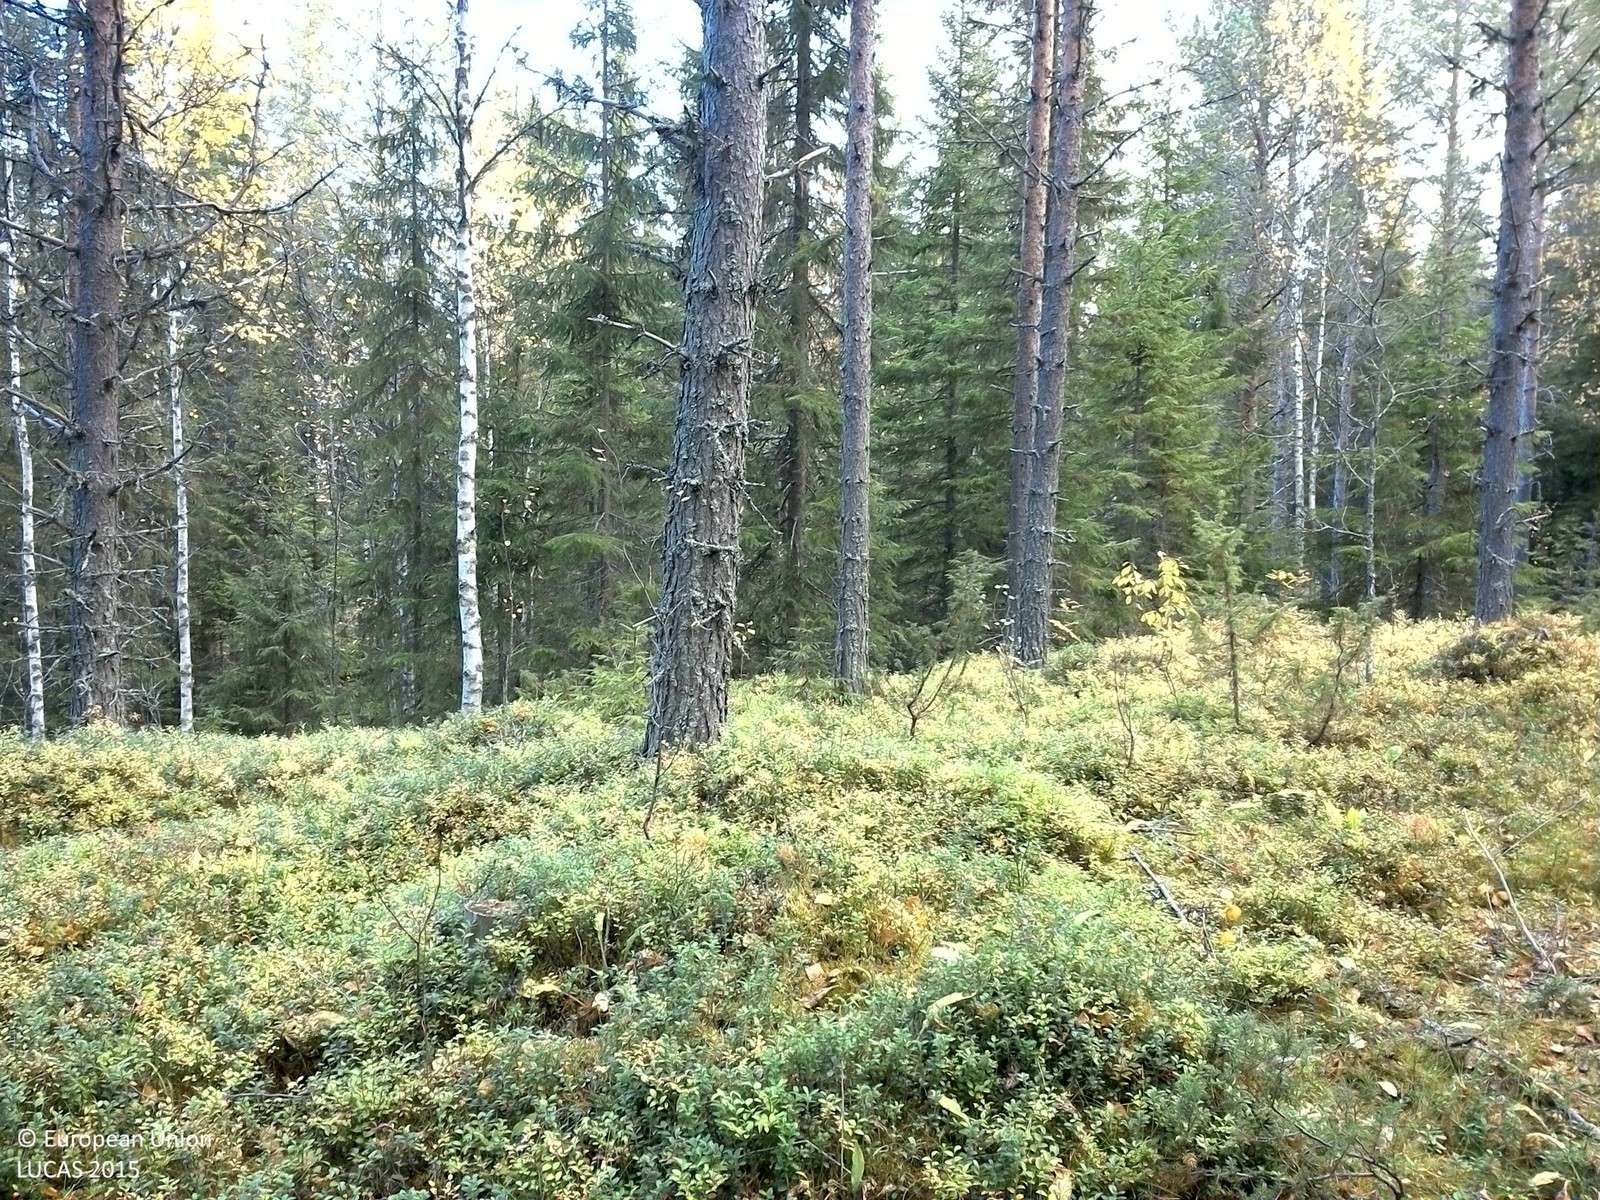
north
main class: Woodland
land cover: Other mixed woodland
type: boreal forest
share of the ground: 50 - 75 %
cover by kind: coniferous forest trees 35 %, shrubs 30 %, broadleaved forest trees 20 %, lichens and mosses 10 %, herbaceous plants 5 %
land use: Forestry
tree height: > 5 m
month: September
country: SE
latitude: 64.2172
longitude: 16.3370
